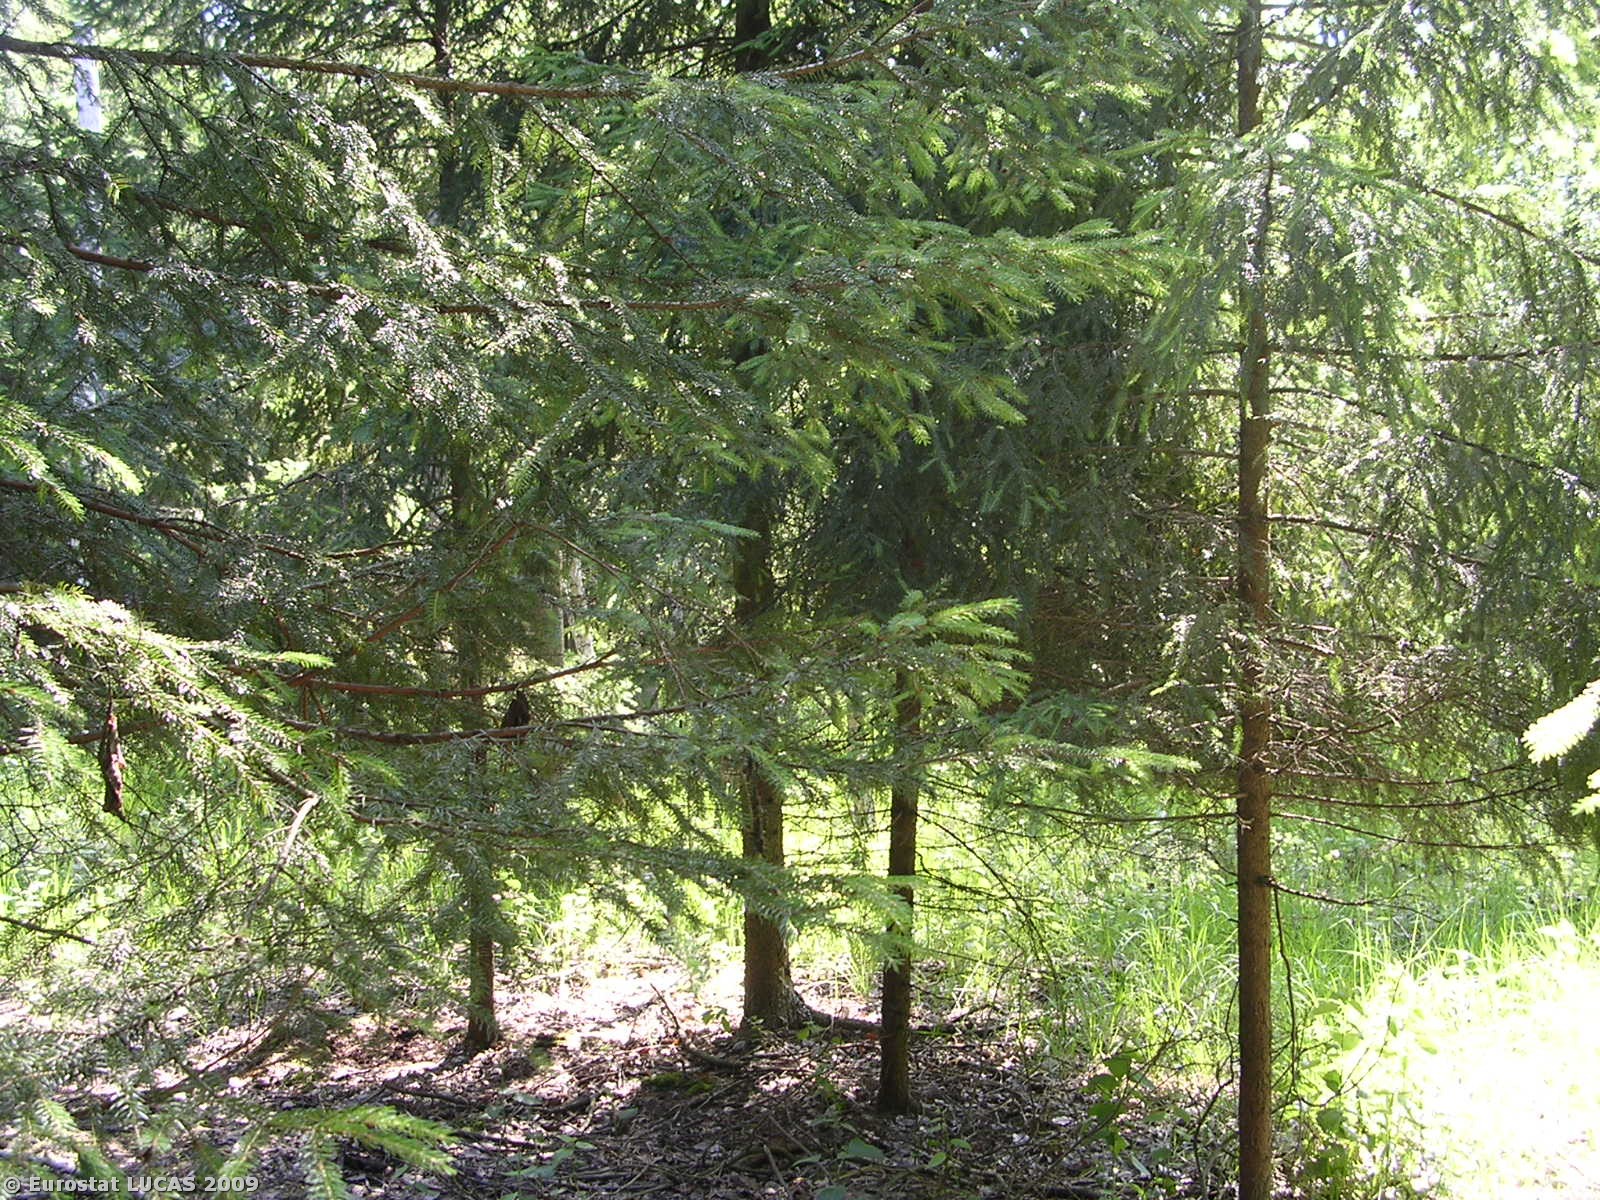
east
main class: Woodland
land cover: Coniferous woodland
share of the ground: > 75 %
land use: Forestry
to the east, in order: Coniferous woodland; Broadleaved woodland; Tracks; Broadleaved woodland; Tracks; Mixed woodland; Coniferous woodland; Mixed woodland; Tracks; Bare land
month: June
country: CZ
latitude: 50.4516
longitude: 15.0309
